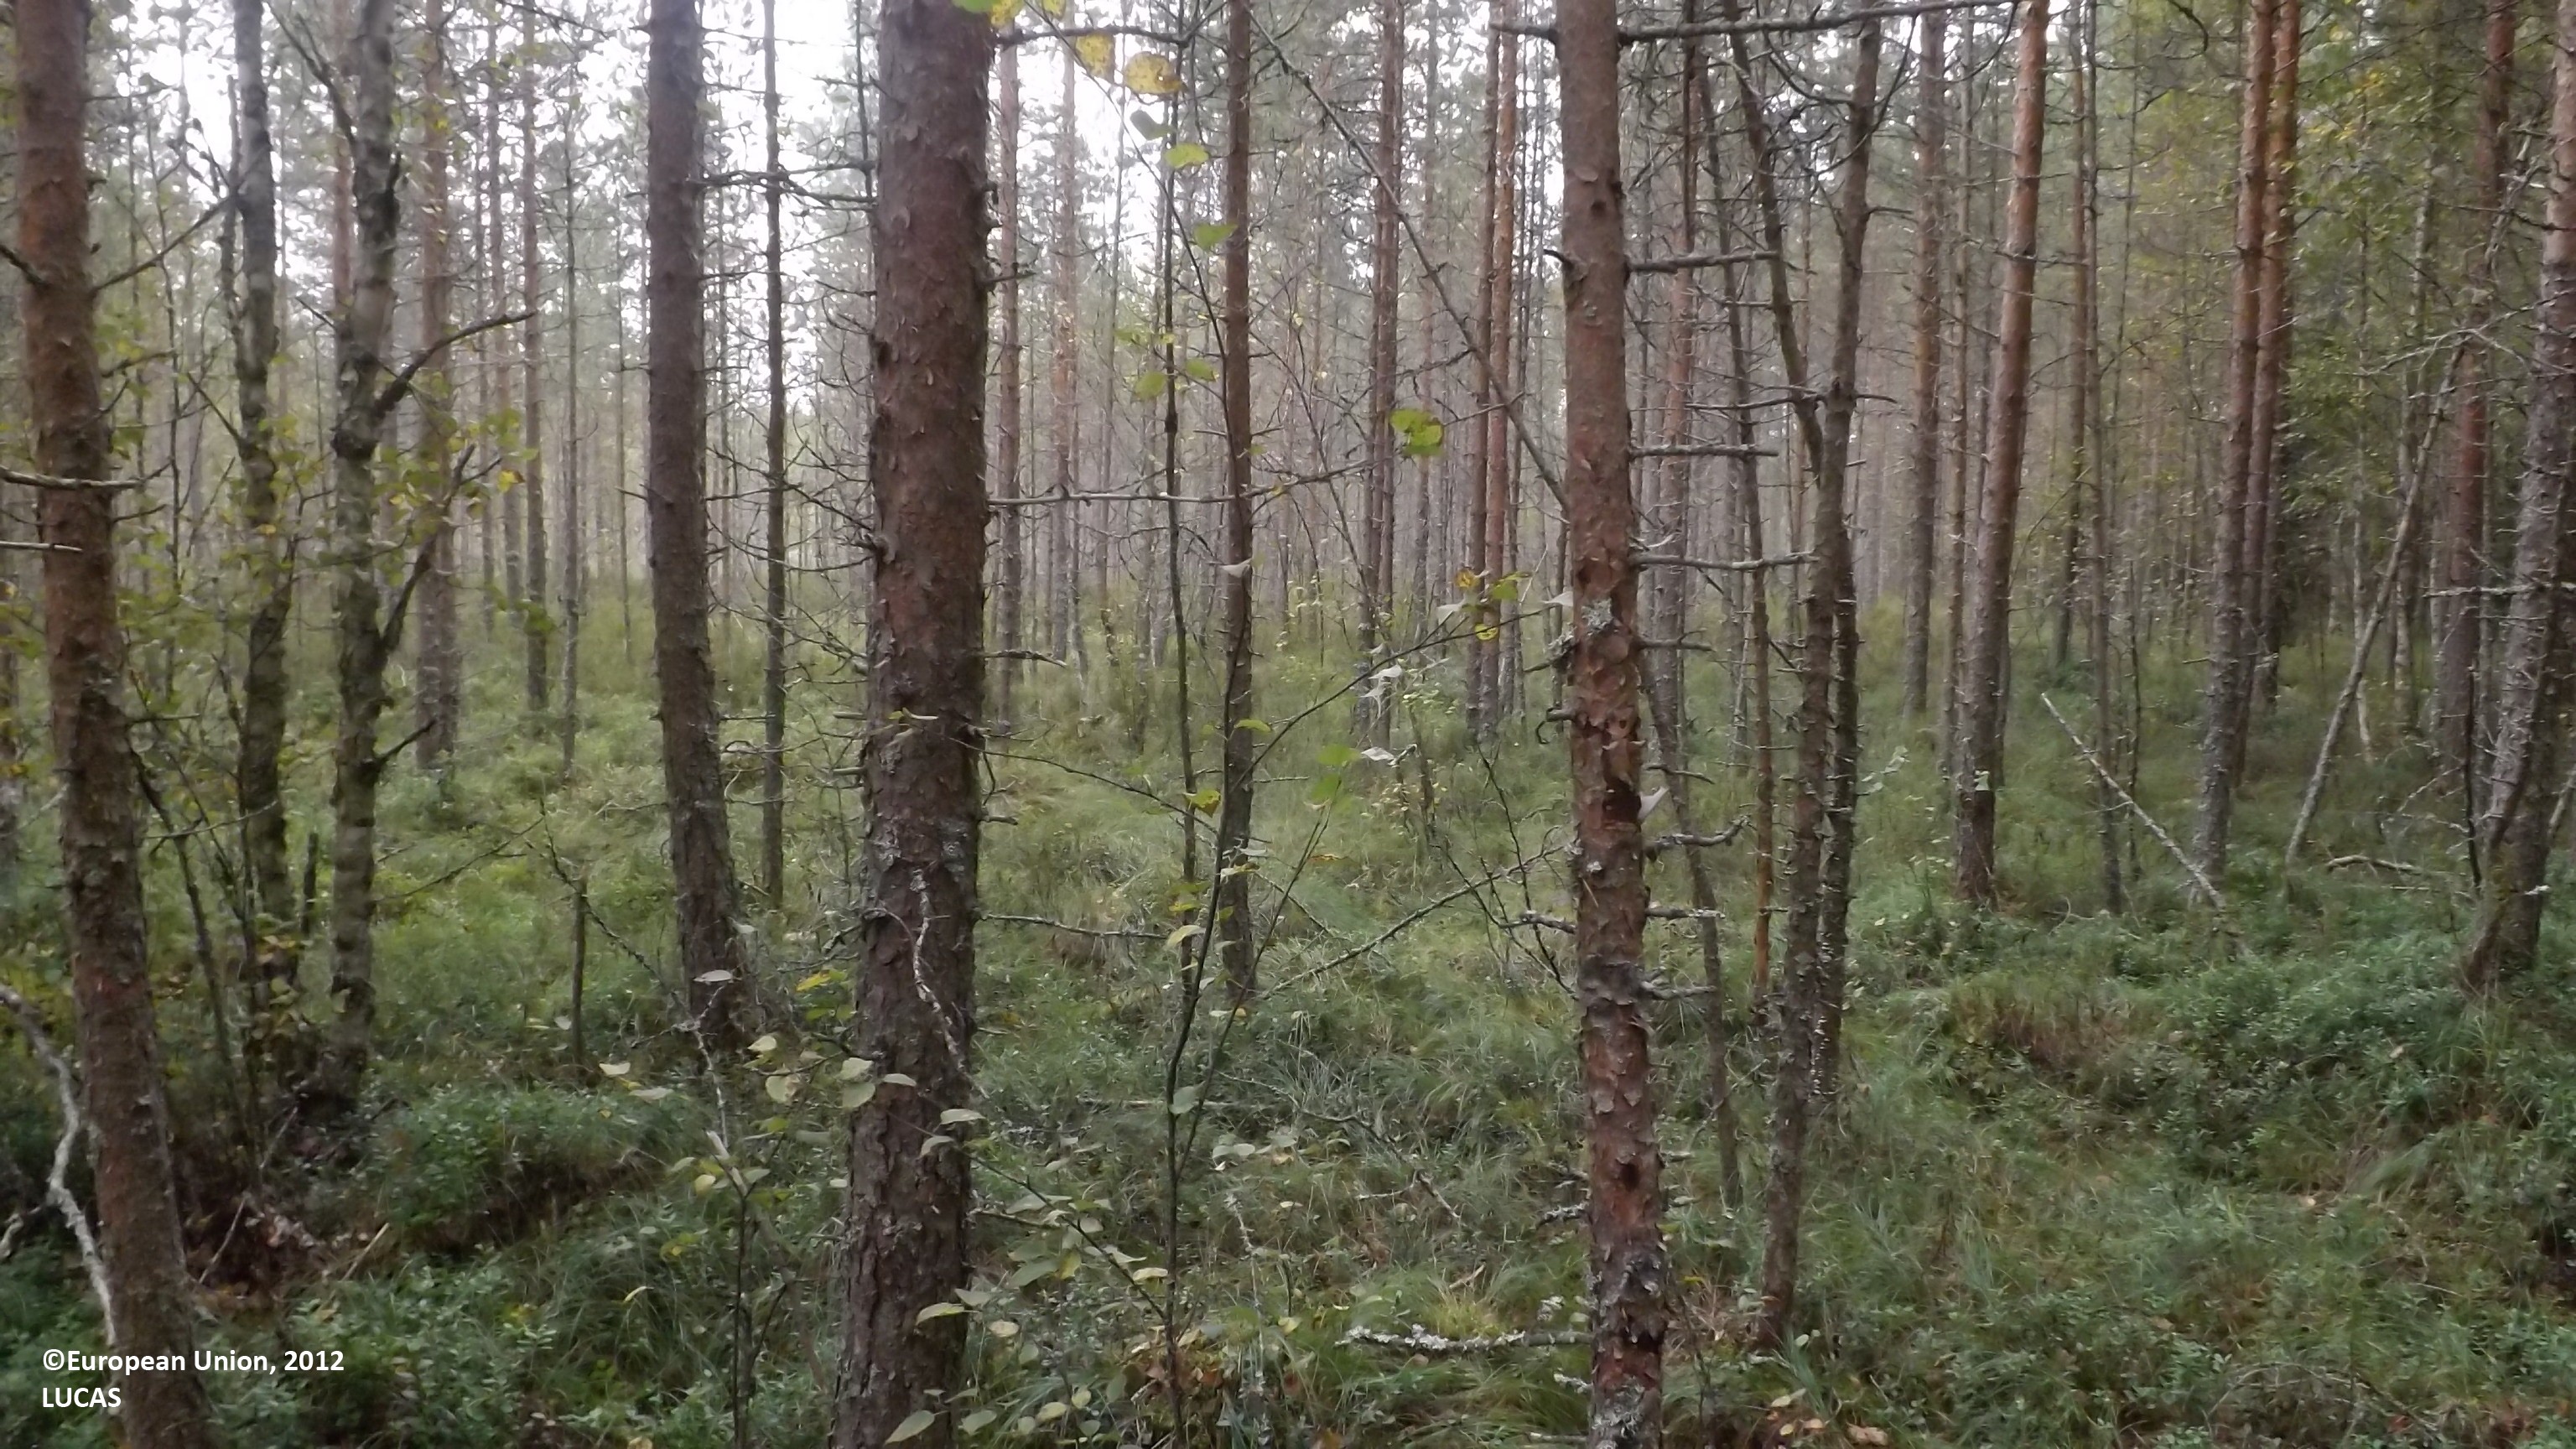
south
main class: Woodland
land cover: Pine dominated mixed woodland
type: boreal forest
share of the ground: > 75 %
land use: Forestry
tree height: > 5 m
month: August
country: FI
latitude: 63.8299
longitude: 23.5743
